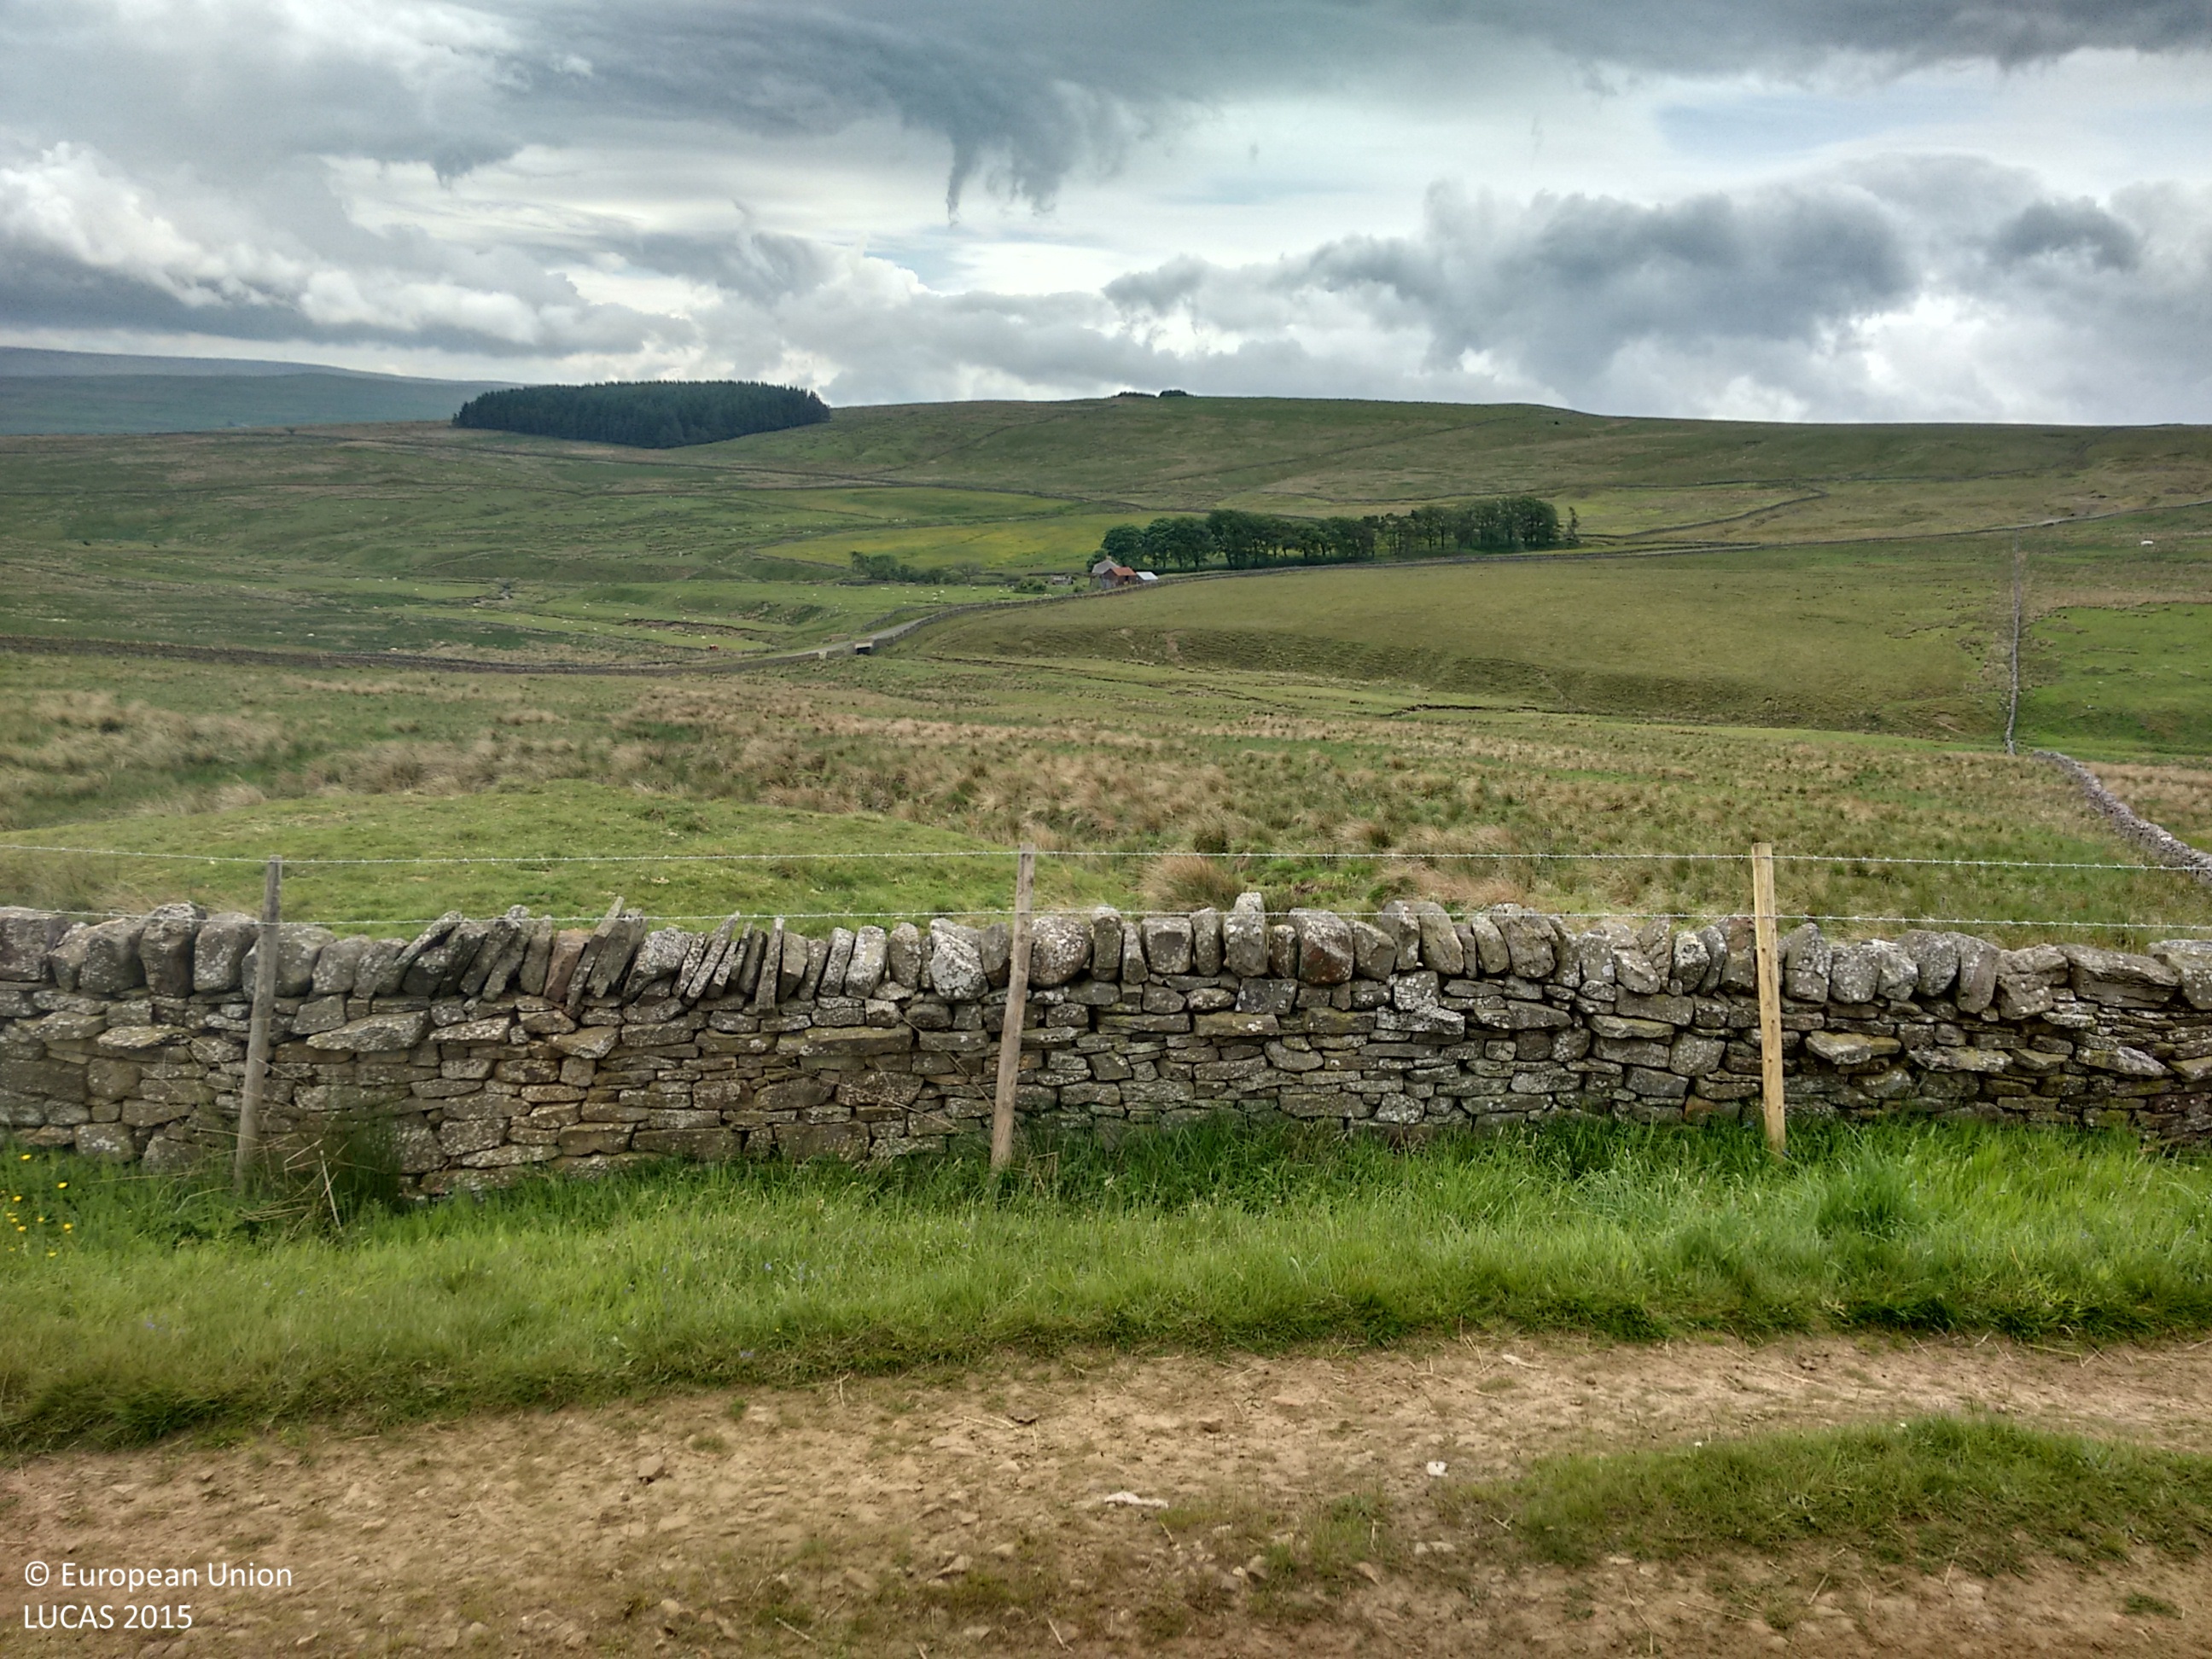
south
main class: Grassland
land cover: Grassland without tree/shrub cover
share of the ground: > 75 %
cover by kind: herbaceous plants 100 %
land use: Agriculture (excluding fallow land and kitchen gardens)
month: June
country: GB
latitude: 54.7689
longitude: -2.1663
